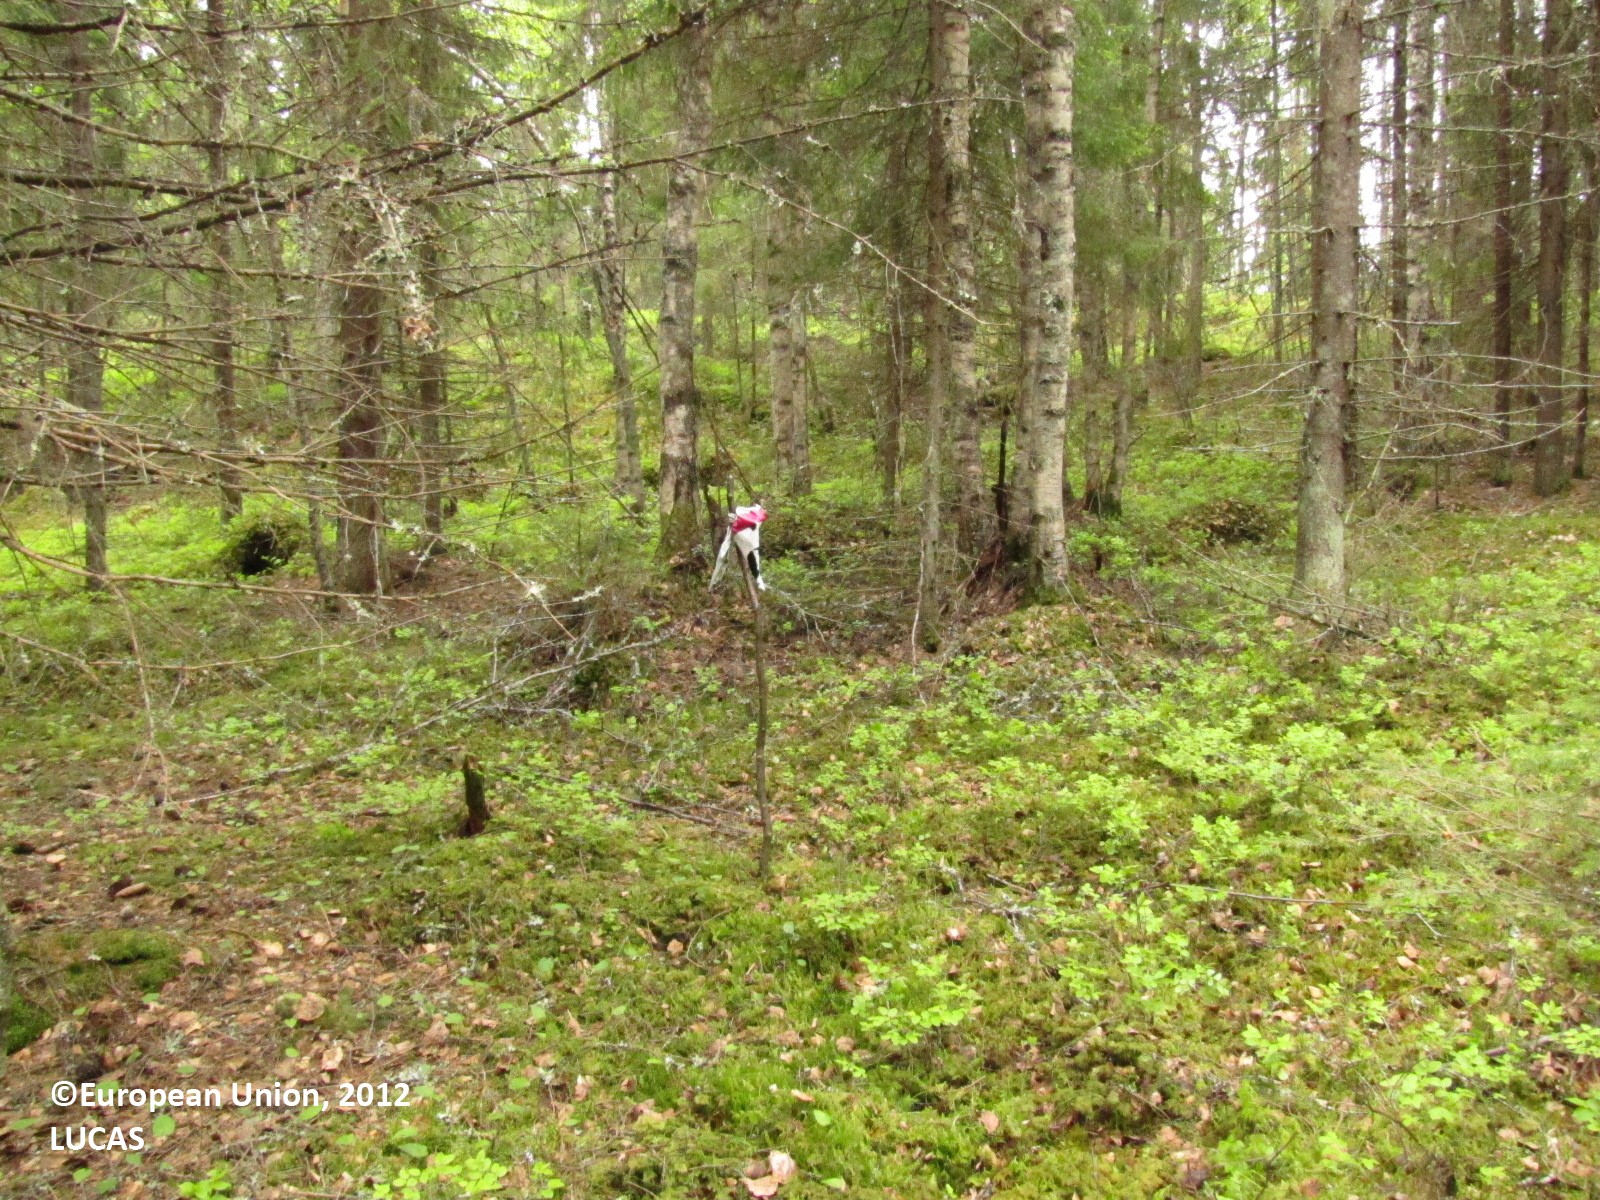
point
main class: Woodland
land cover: Spruce dominated mixed woodland
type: hemiboreal forest and nemoral coniferous forest and mixed broadleaved-coniferous forest
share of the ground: 50 - 75 %
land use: Forestry
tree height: > 5 m
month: June
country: FI
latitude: 61.4886
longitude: 23.0870
